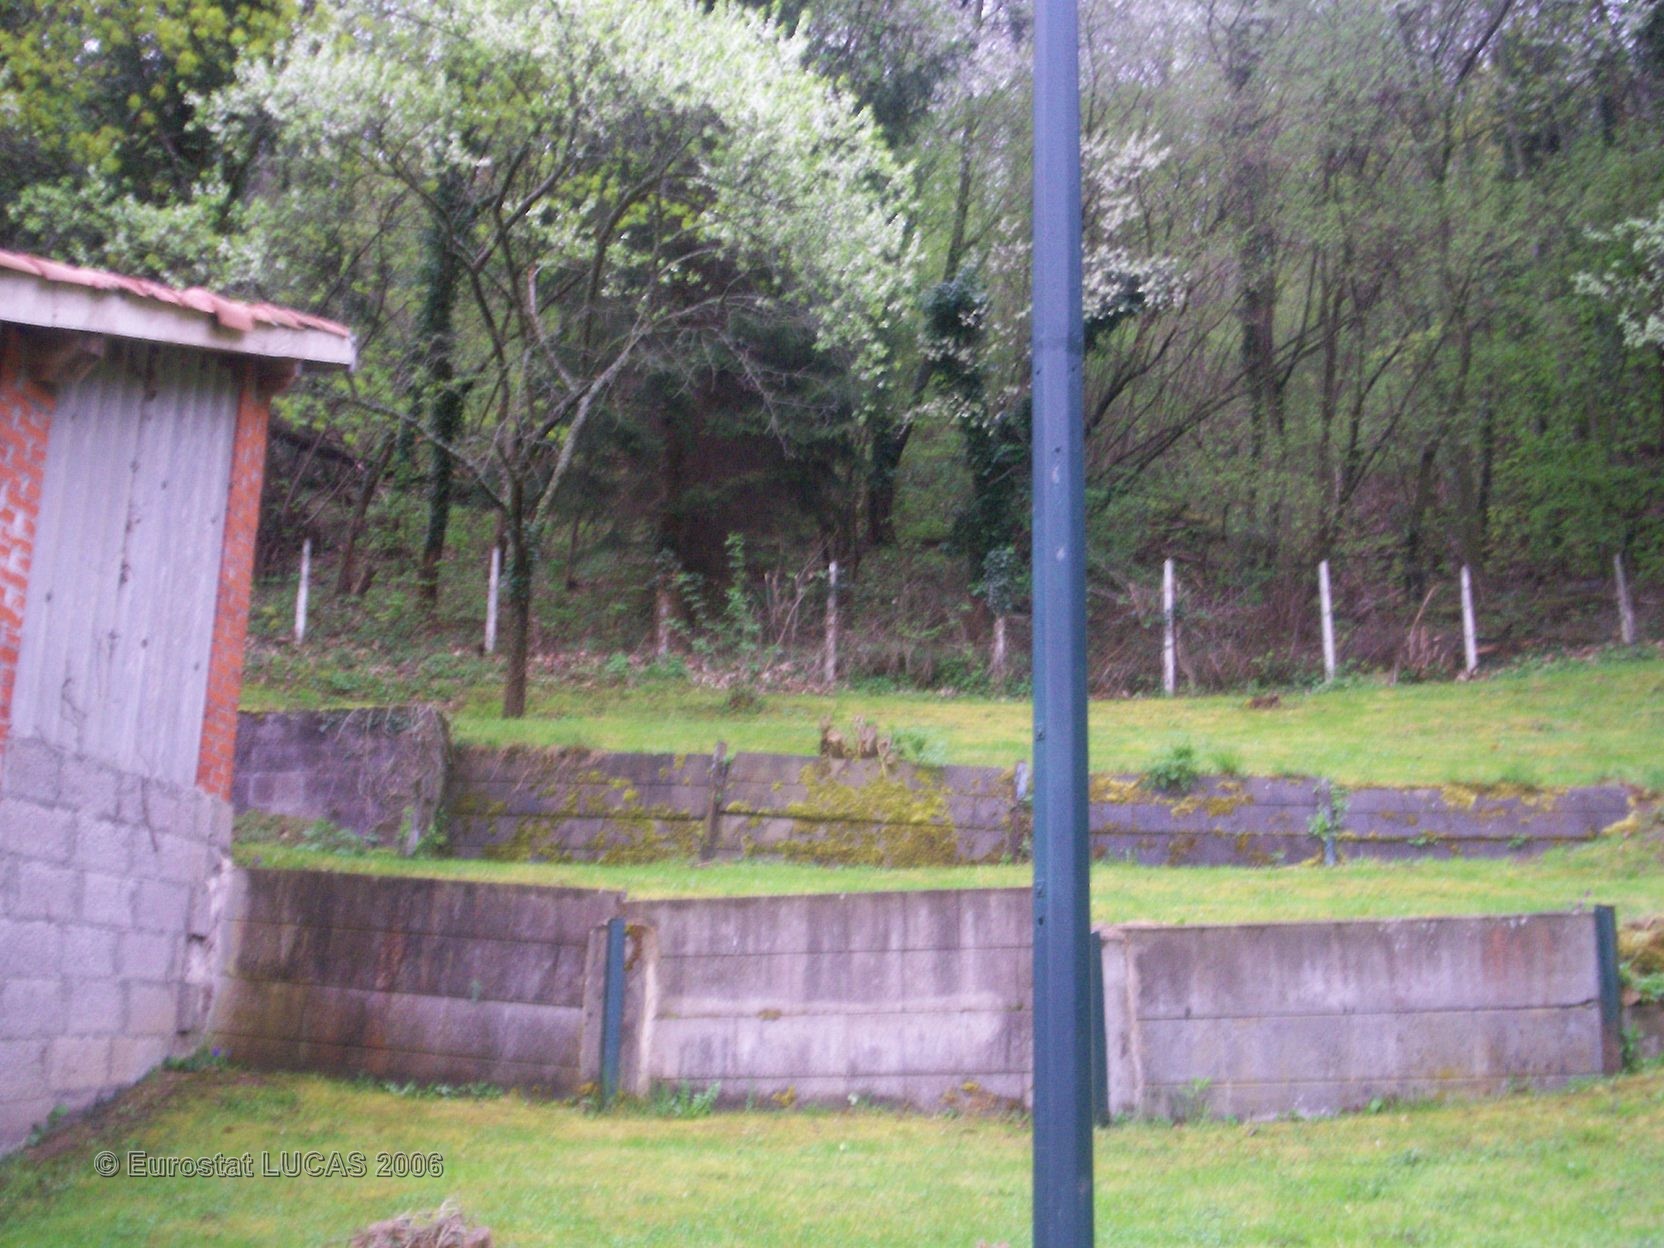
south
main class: Grassland
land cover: Grassland with sparse tree/shrub cover
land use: Residential
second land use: Kitchen garden
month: April
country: FR
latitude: 45.7631
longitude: 3.0436
